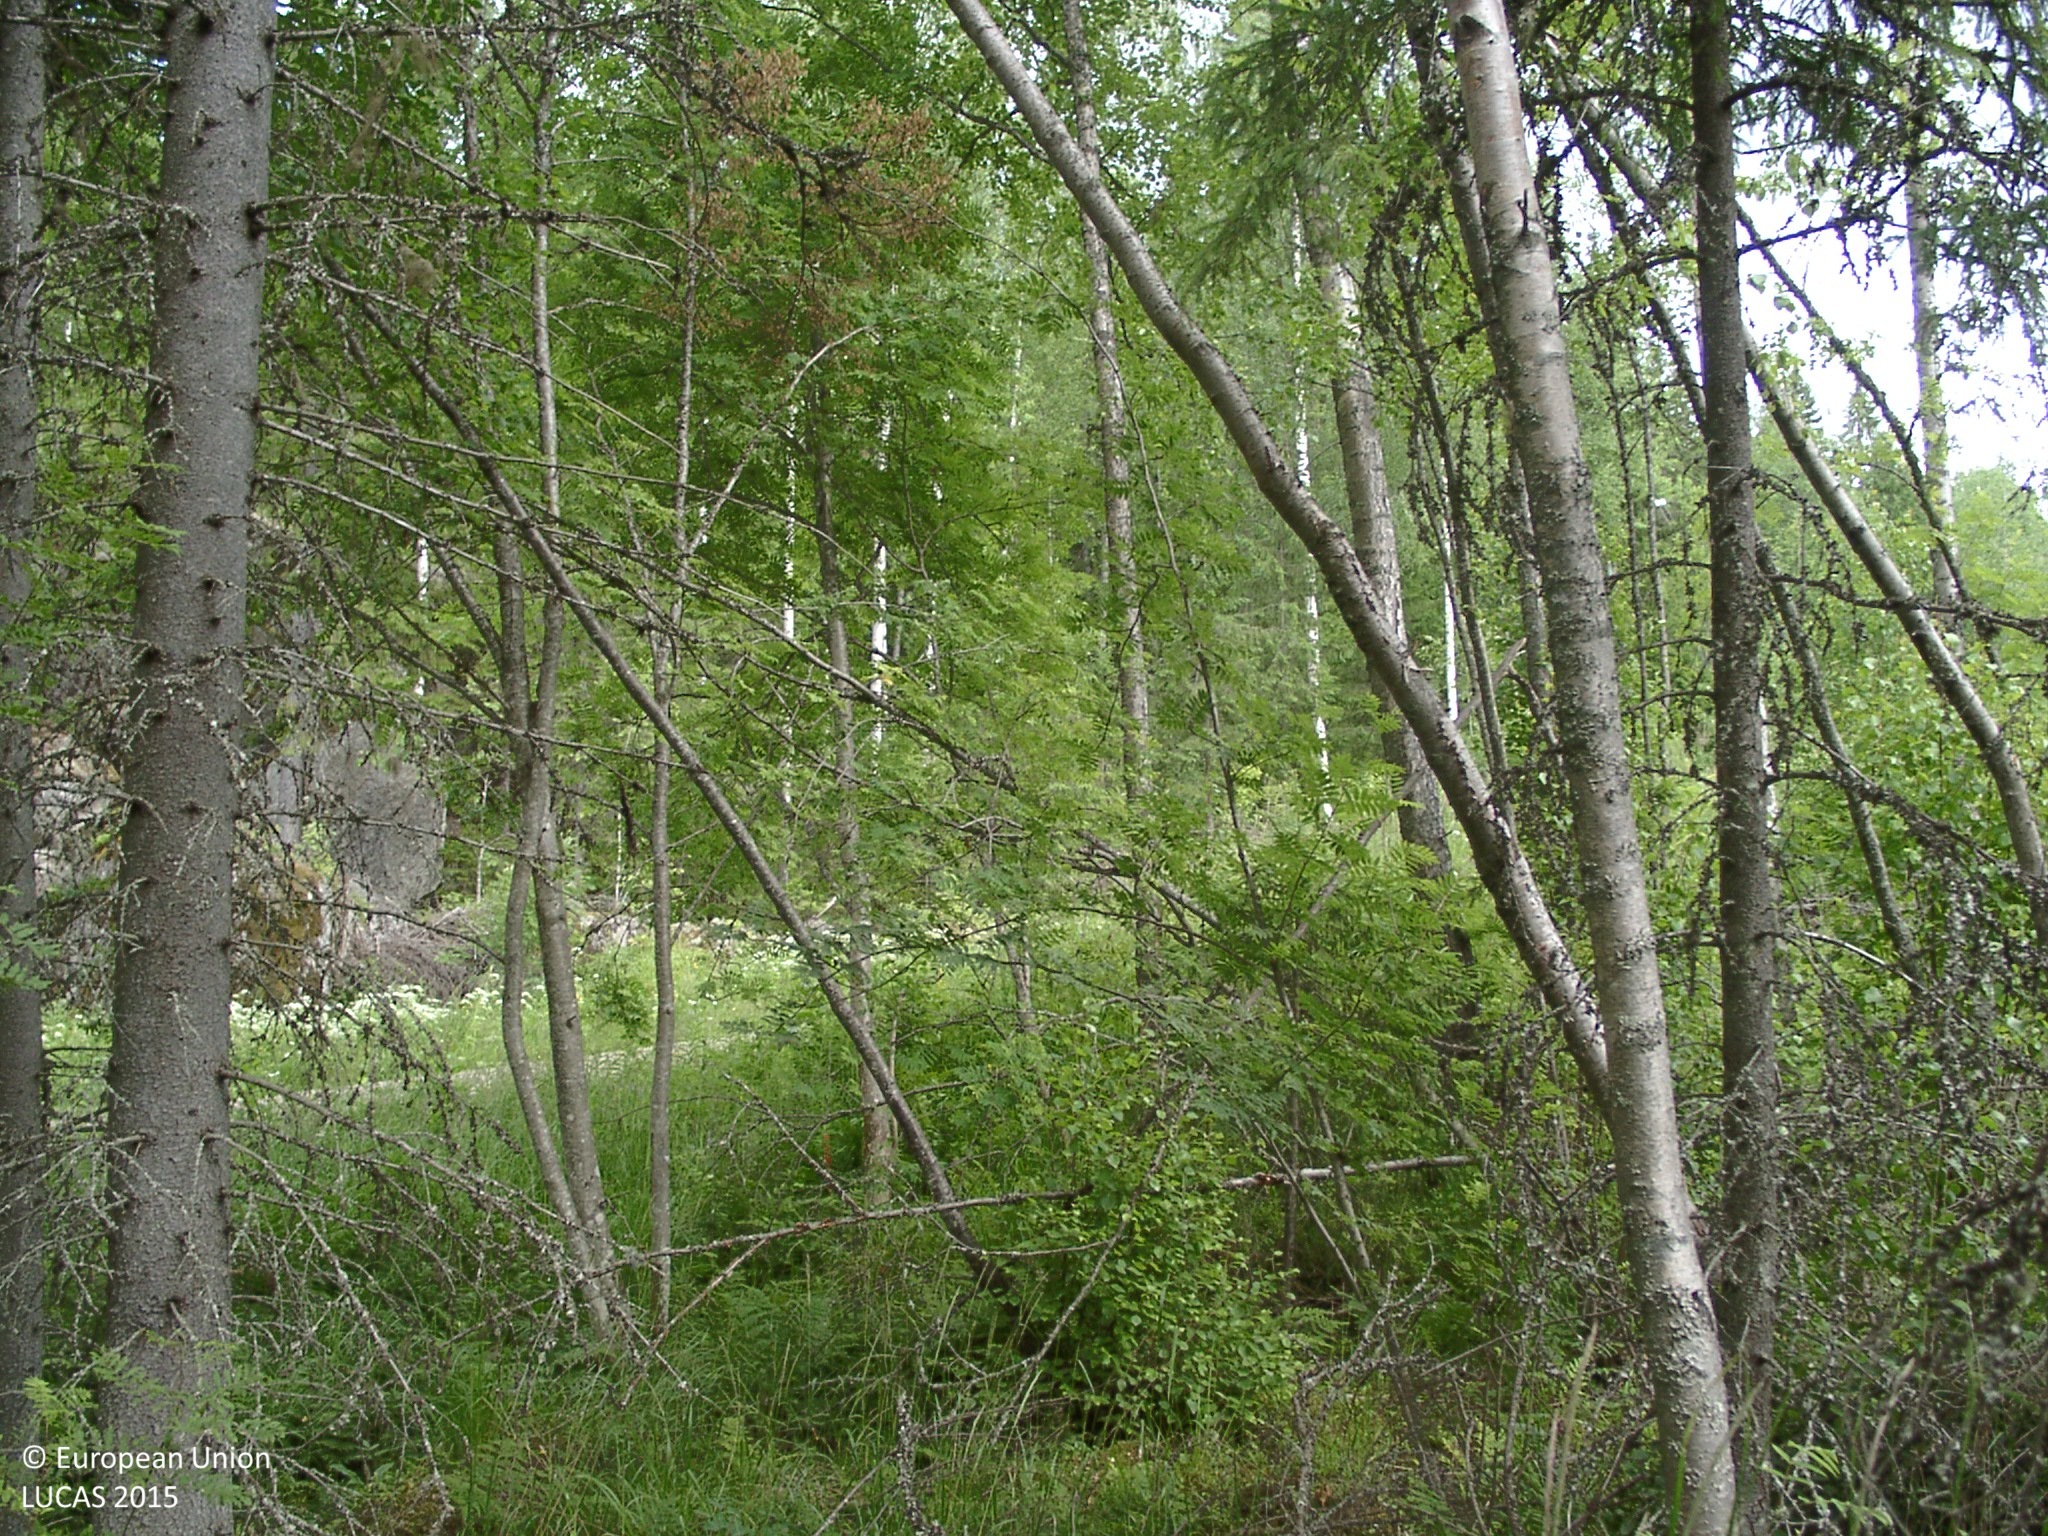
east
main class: Woodland
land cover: Spruce dominated mixed woodland
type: boreal forest
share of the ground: > 75 %
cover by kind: coniferous forest trees 40 %, broadleaved forest trees 35 %, shrubs 15 %, herbaceous plants 10 %
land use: Forestry
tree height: > 5 m
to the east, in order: Spruce dominated mixed woodland; Shruby margins; Paved roads, cycling and walking lanes; Shruby margins; Rocks and stones; Spruce dominated mixed woodland; Electric lines; Shrubland with sparse tree cover; Spruce dominated mixed woodland; Tracks; Spruce dominated coniferous woodland; Other mixed woodland; Pine dominated mixed woodland; Other coniferous woodland
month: July
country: FI
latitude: 61.6501
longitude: 25.1959
